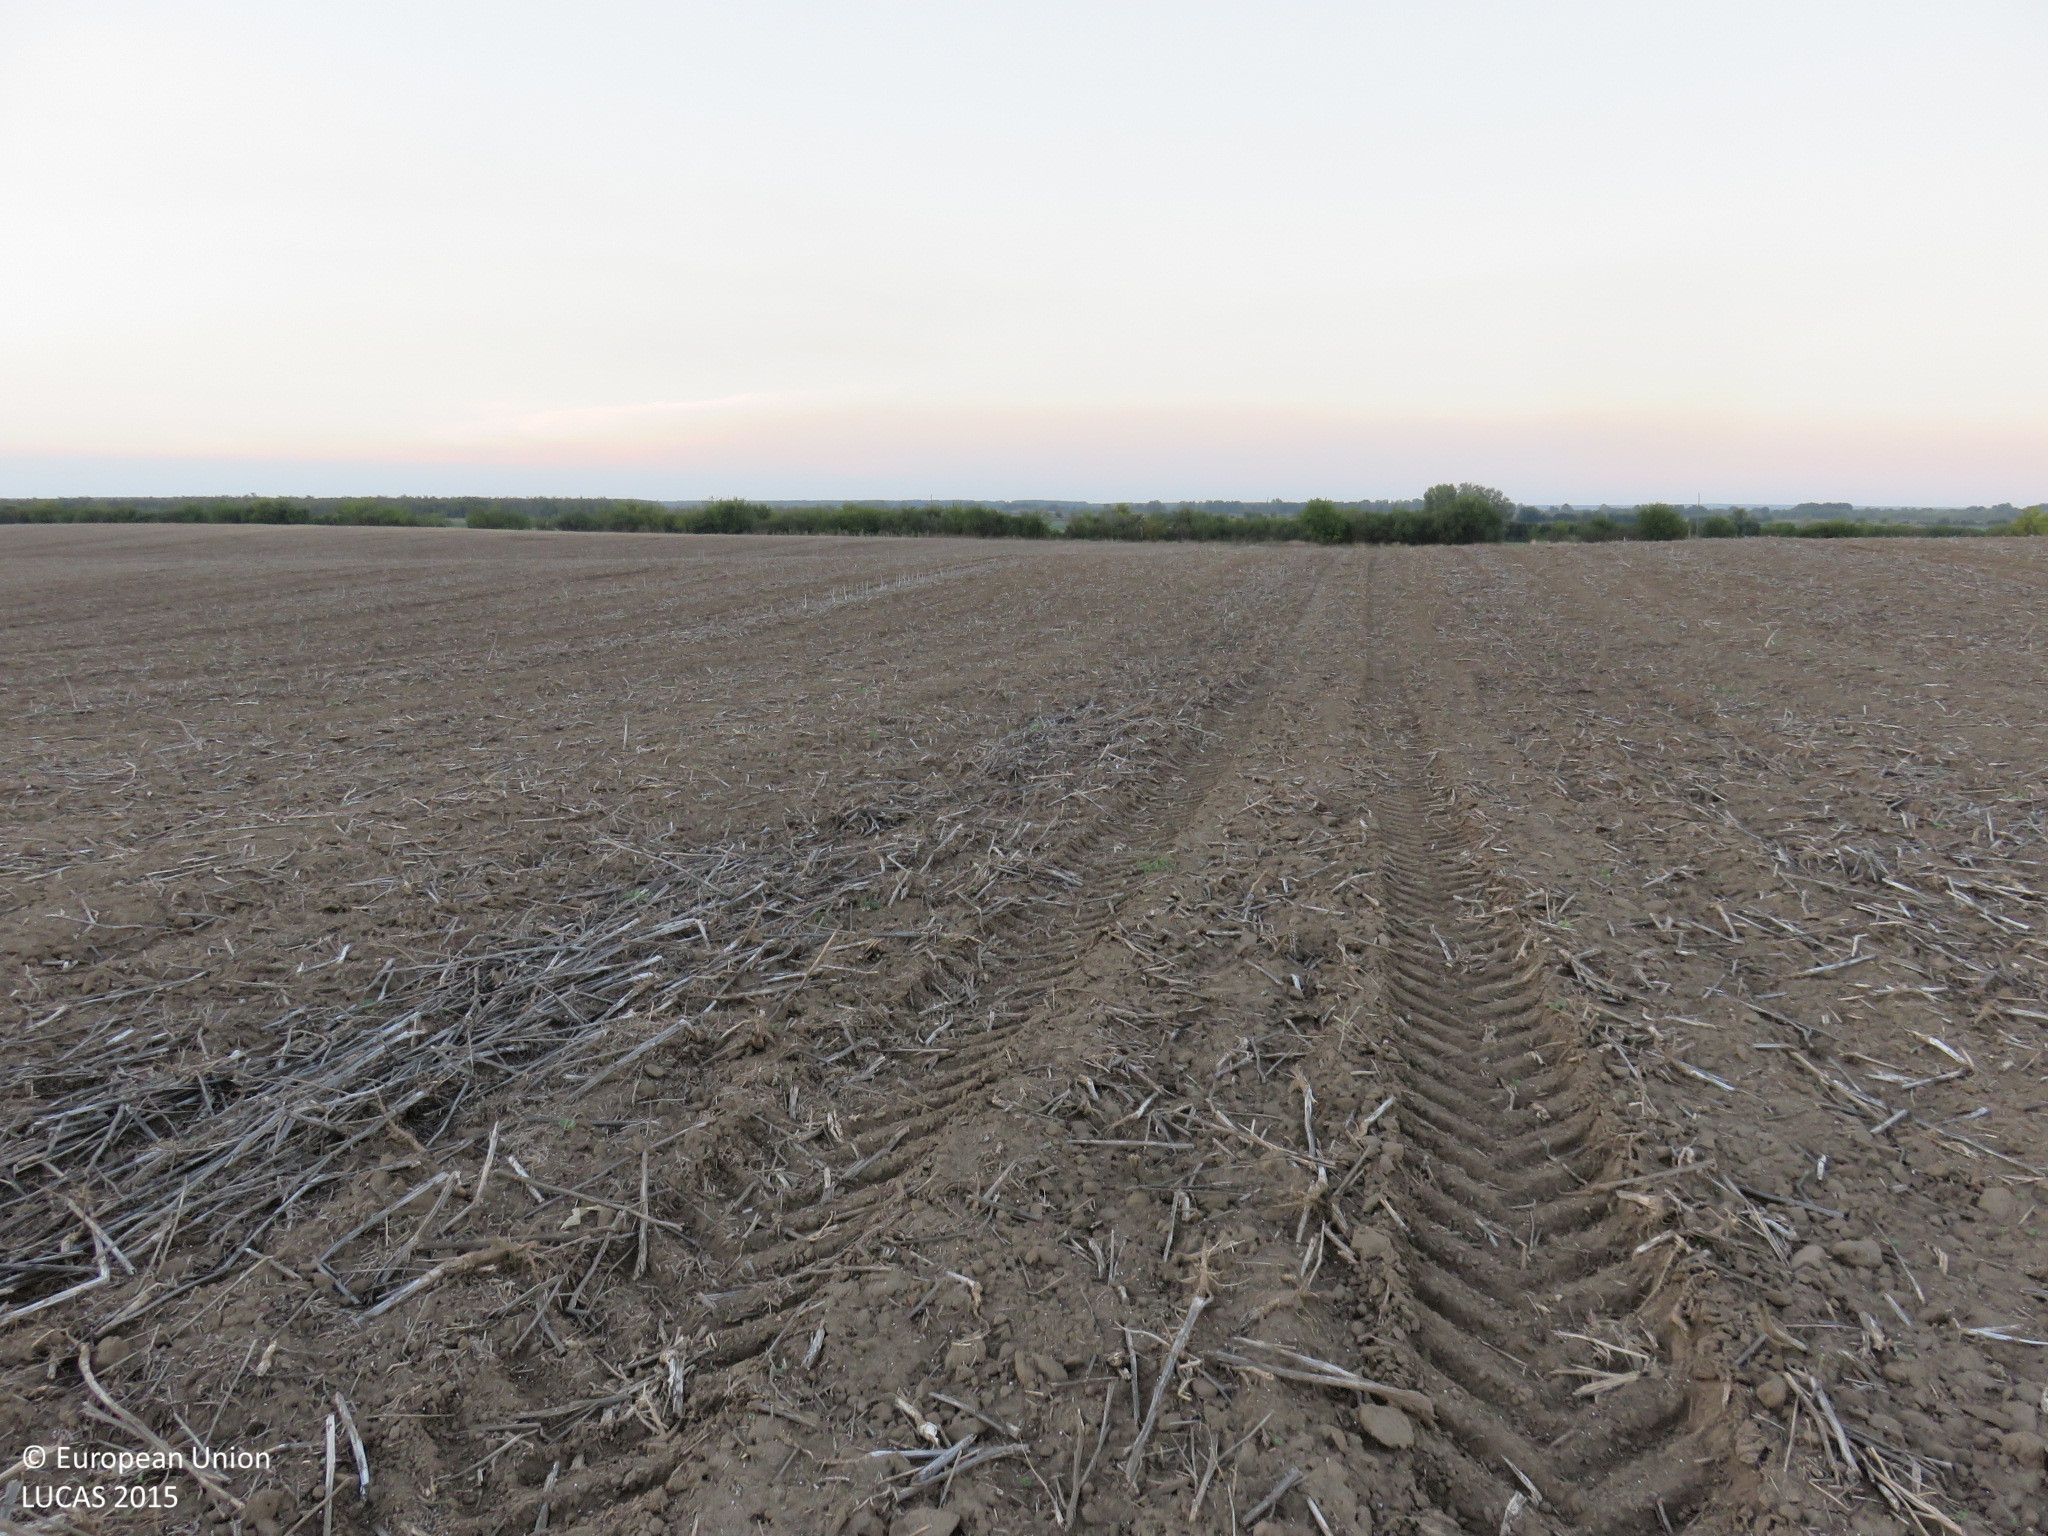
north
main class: Cropland
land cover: Rape and turnip rape
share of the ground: < 10 %
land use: Agriculture (excluding fallow land and kitchen gardens)
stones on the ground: < 10 %
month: September
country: BG
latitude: 43.6679
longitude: 25.0429
